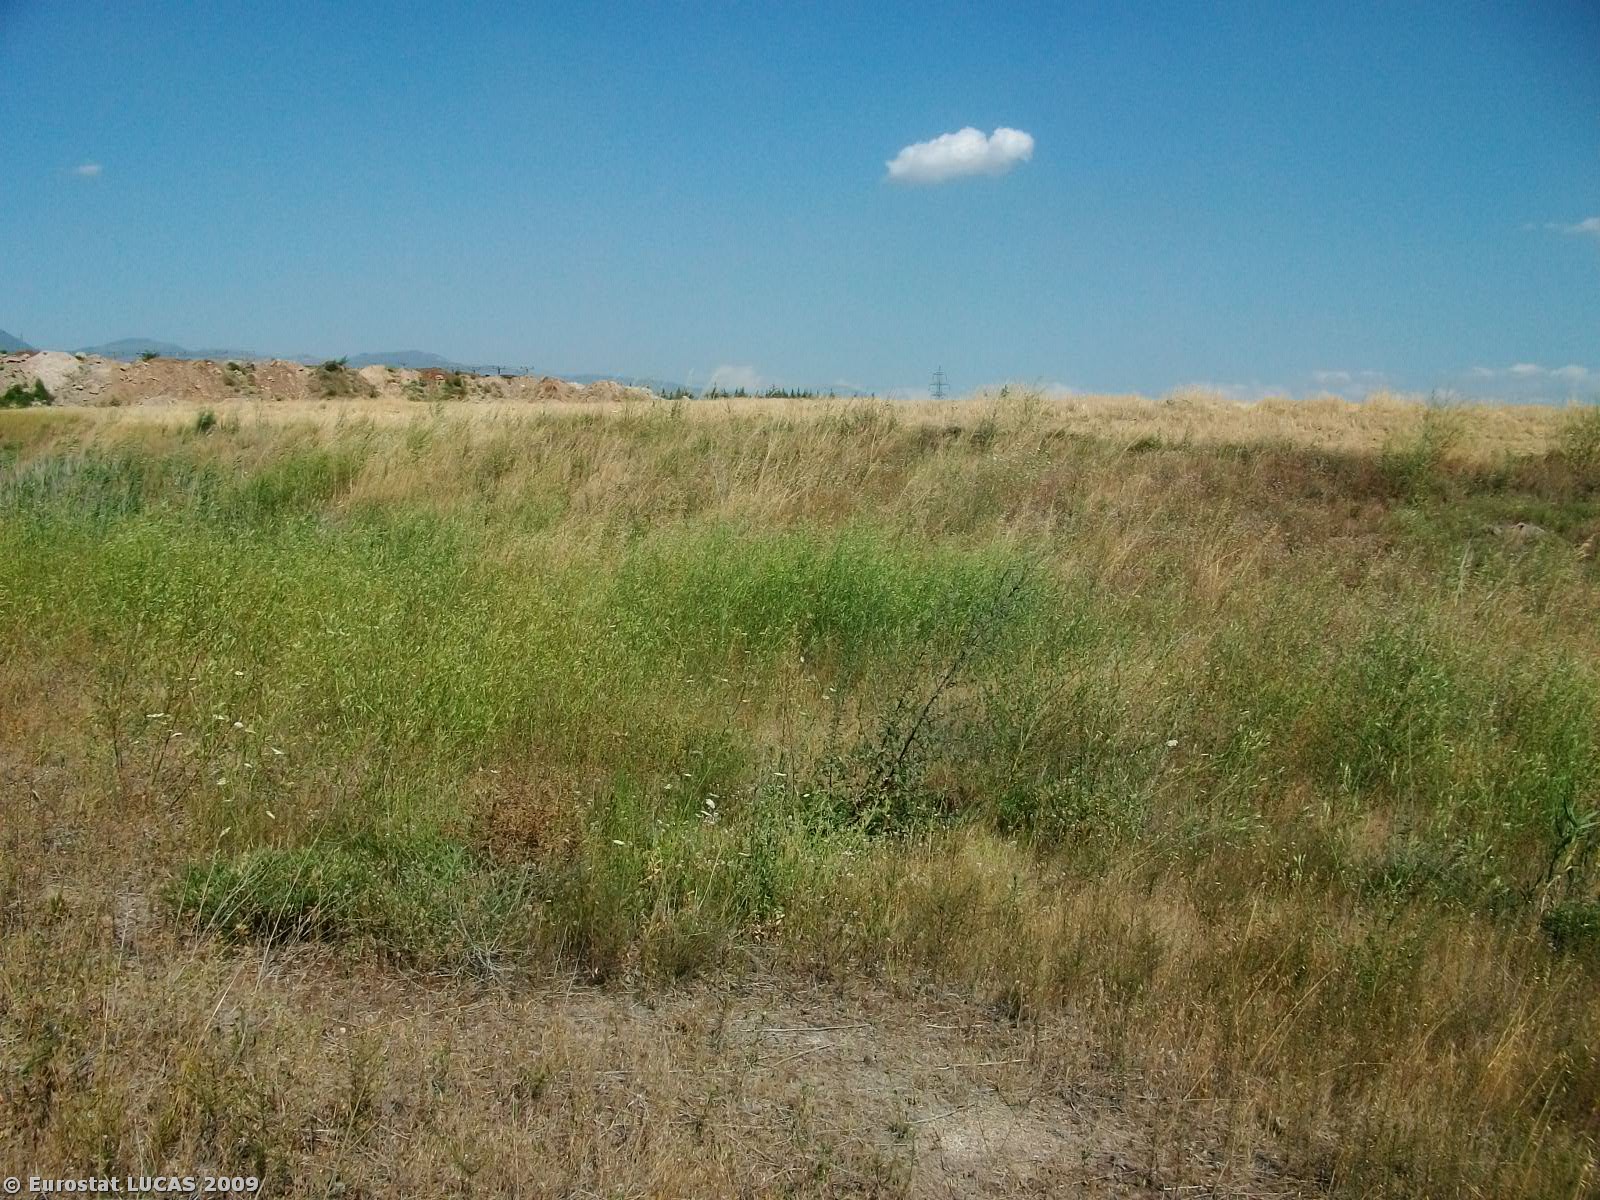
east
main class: Grassland
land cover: Grassland without tree/shrub cover
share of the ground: 50 - 75 %
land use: Unused
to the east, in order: Grassland without tree/shrub cover; Common wheat; Bare land; Paved roads, cycling and walking lanes; Bare land; Coniferous woodland
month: July
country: GR
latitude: 40.4122
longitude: 21.7893
